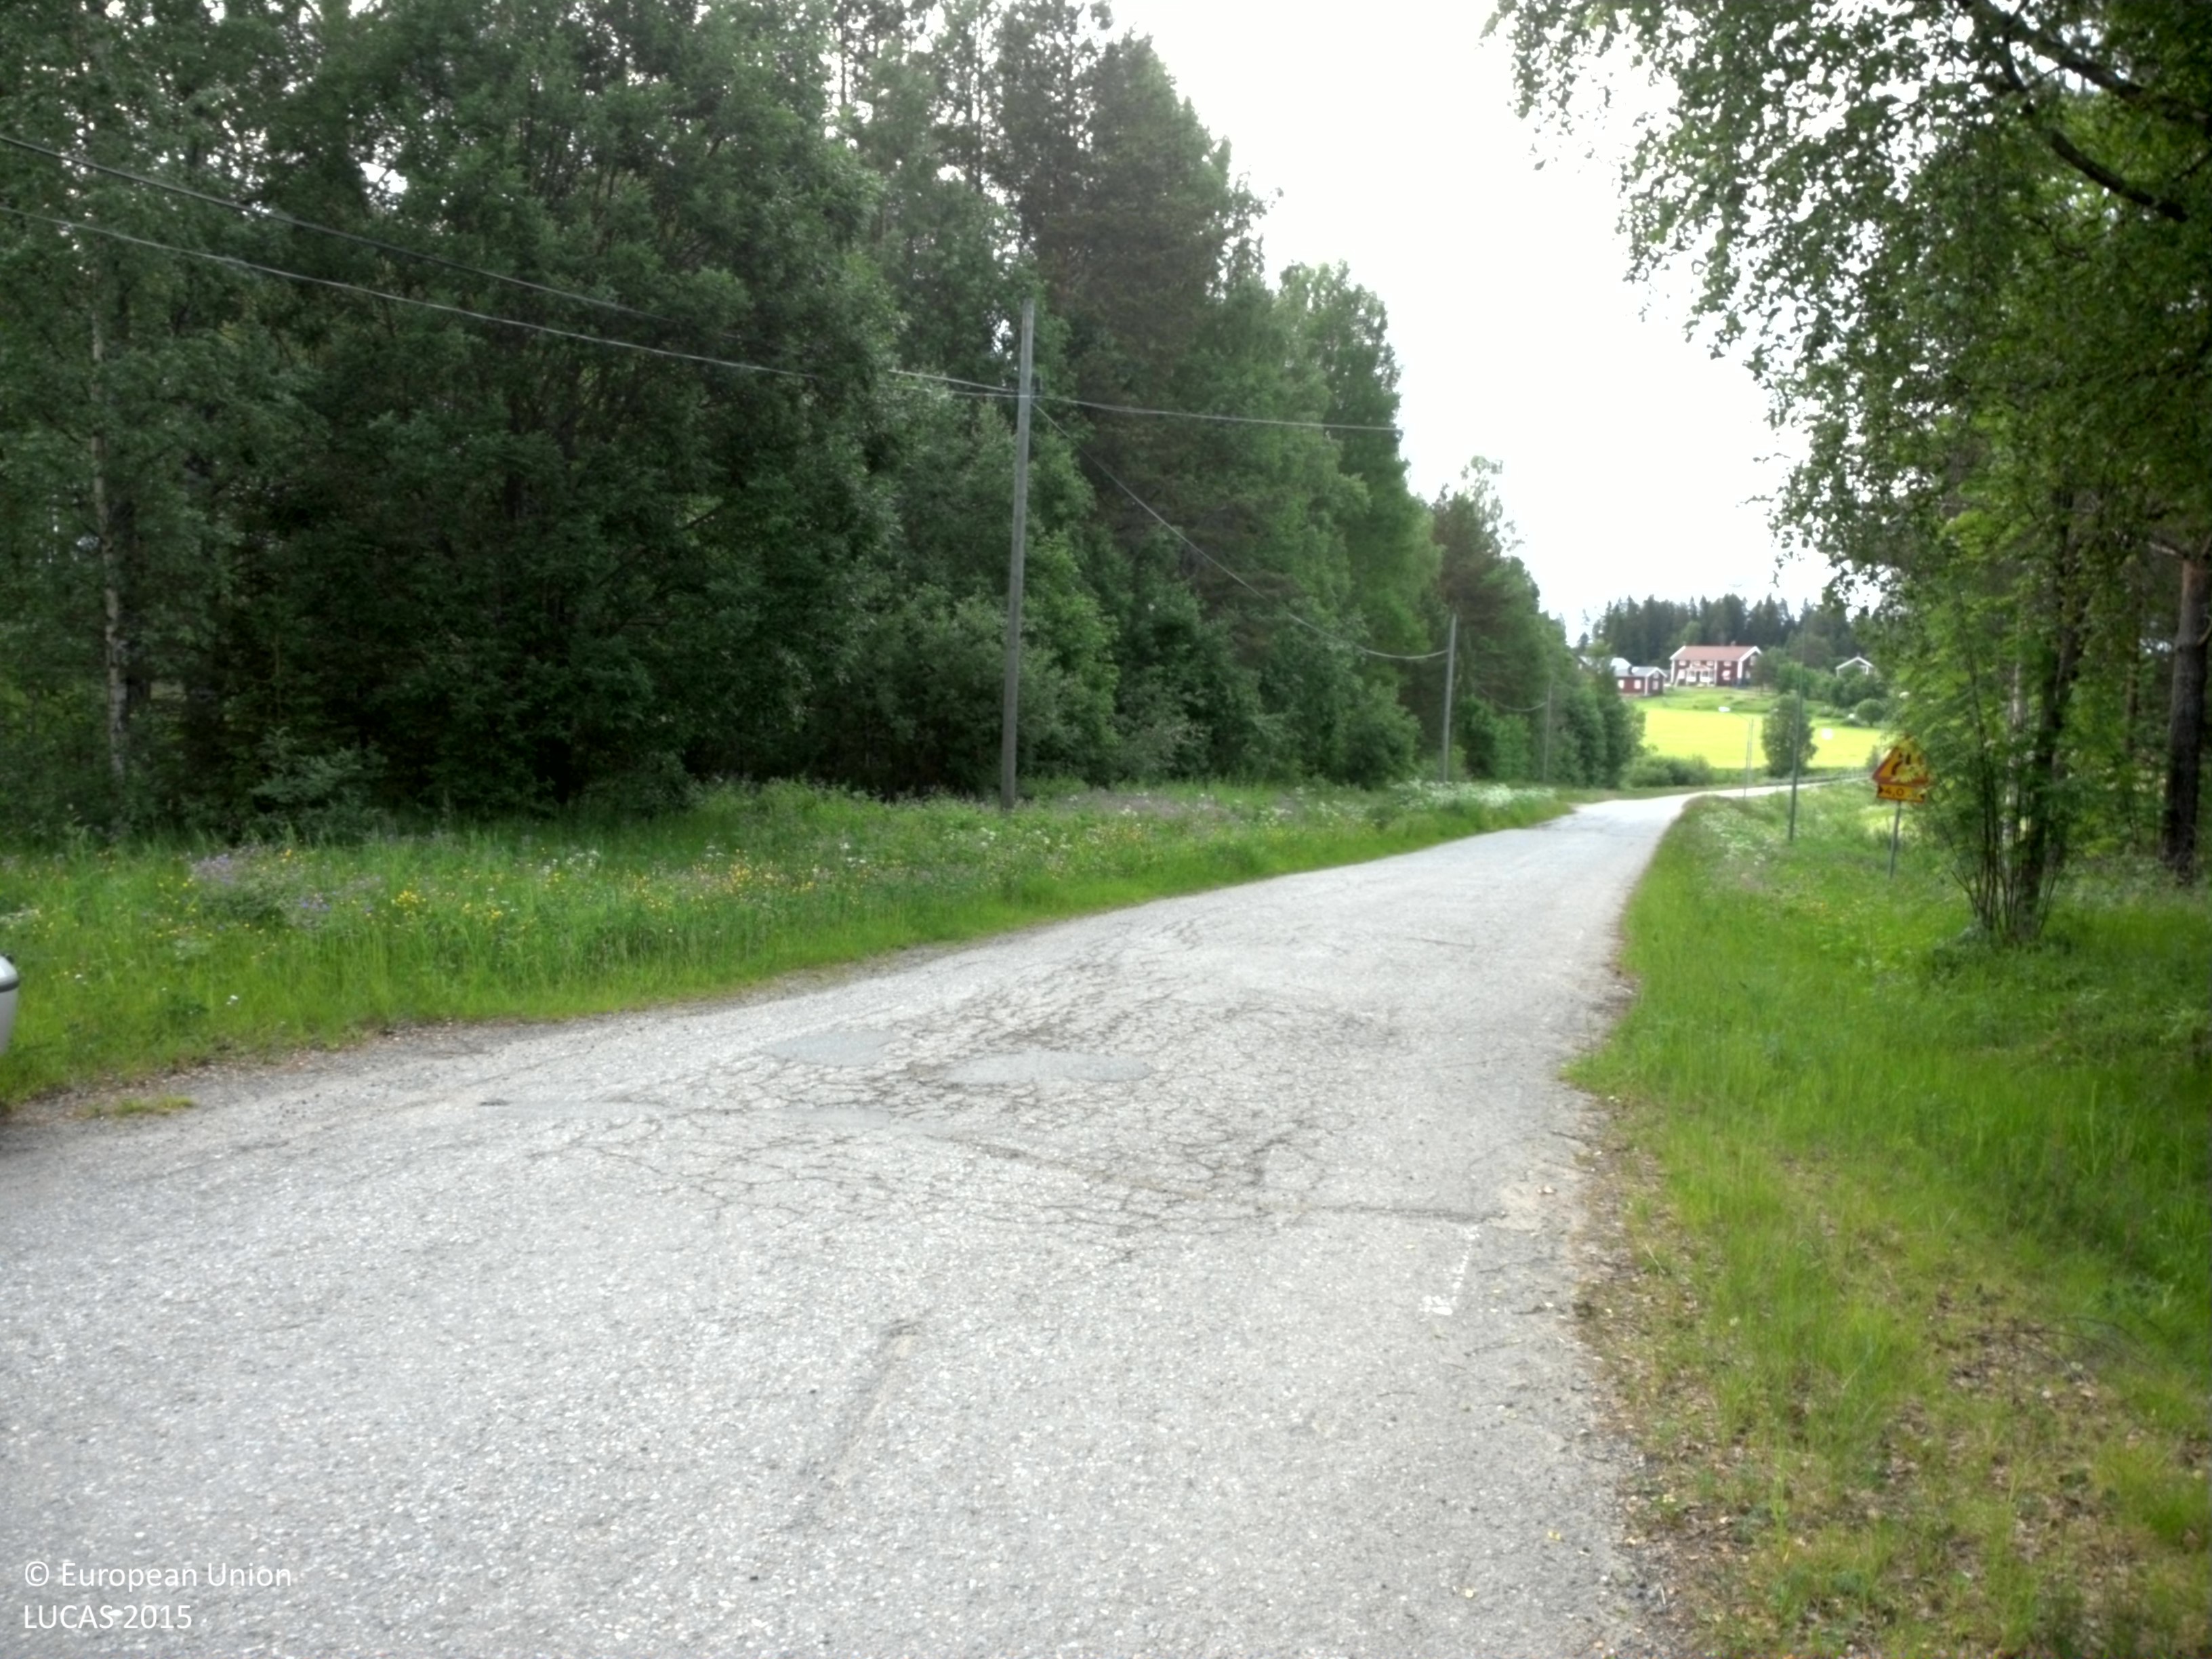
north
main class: Grassland
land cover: Grassland with sparse tree/shrub cover
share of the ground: > 75 %
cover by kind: herbaceous plants 95 %, broadleaved forest trees 5 %
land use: Residential
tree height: > 5 m
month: July
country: SE
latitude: 64.4812
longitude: 20.8606
